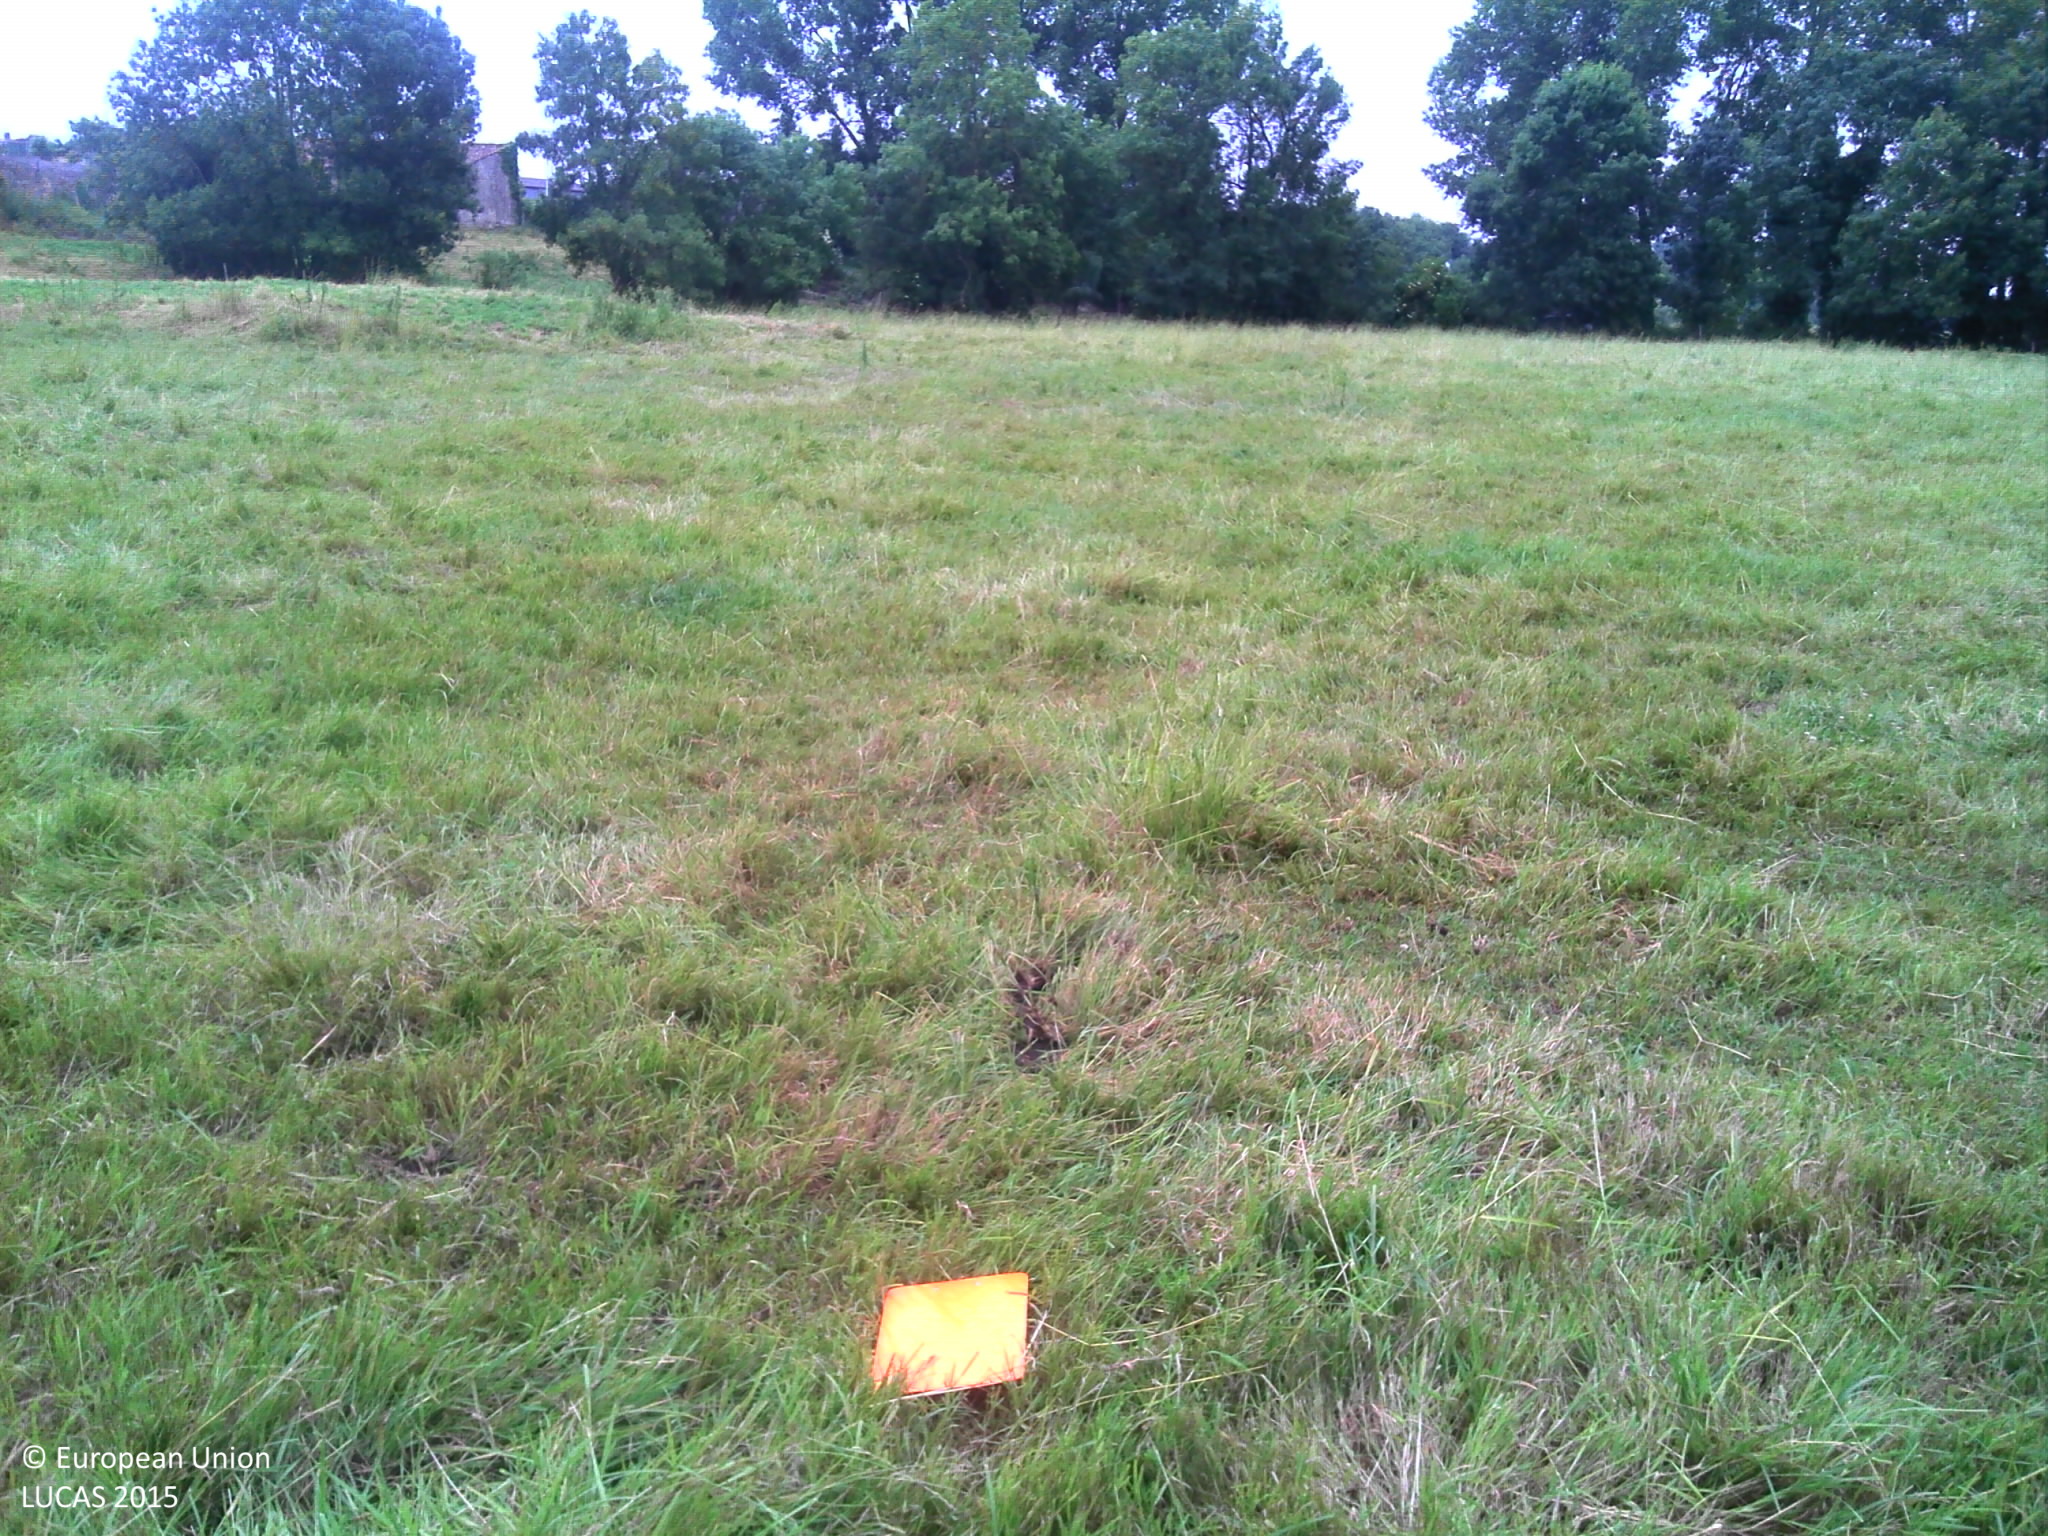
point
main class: Grassland
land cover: Grassland with sparse tree/shrub cover
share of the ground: > 75 %
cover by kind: herbaceous plants 95 %, broadleaved forest trees 5 %
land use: Agriculture (excluding fallow land and kitchen gardens)
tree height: > 5 m
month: June
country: FR
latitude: 45.8817
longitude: -0.9156
